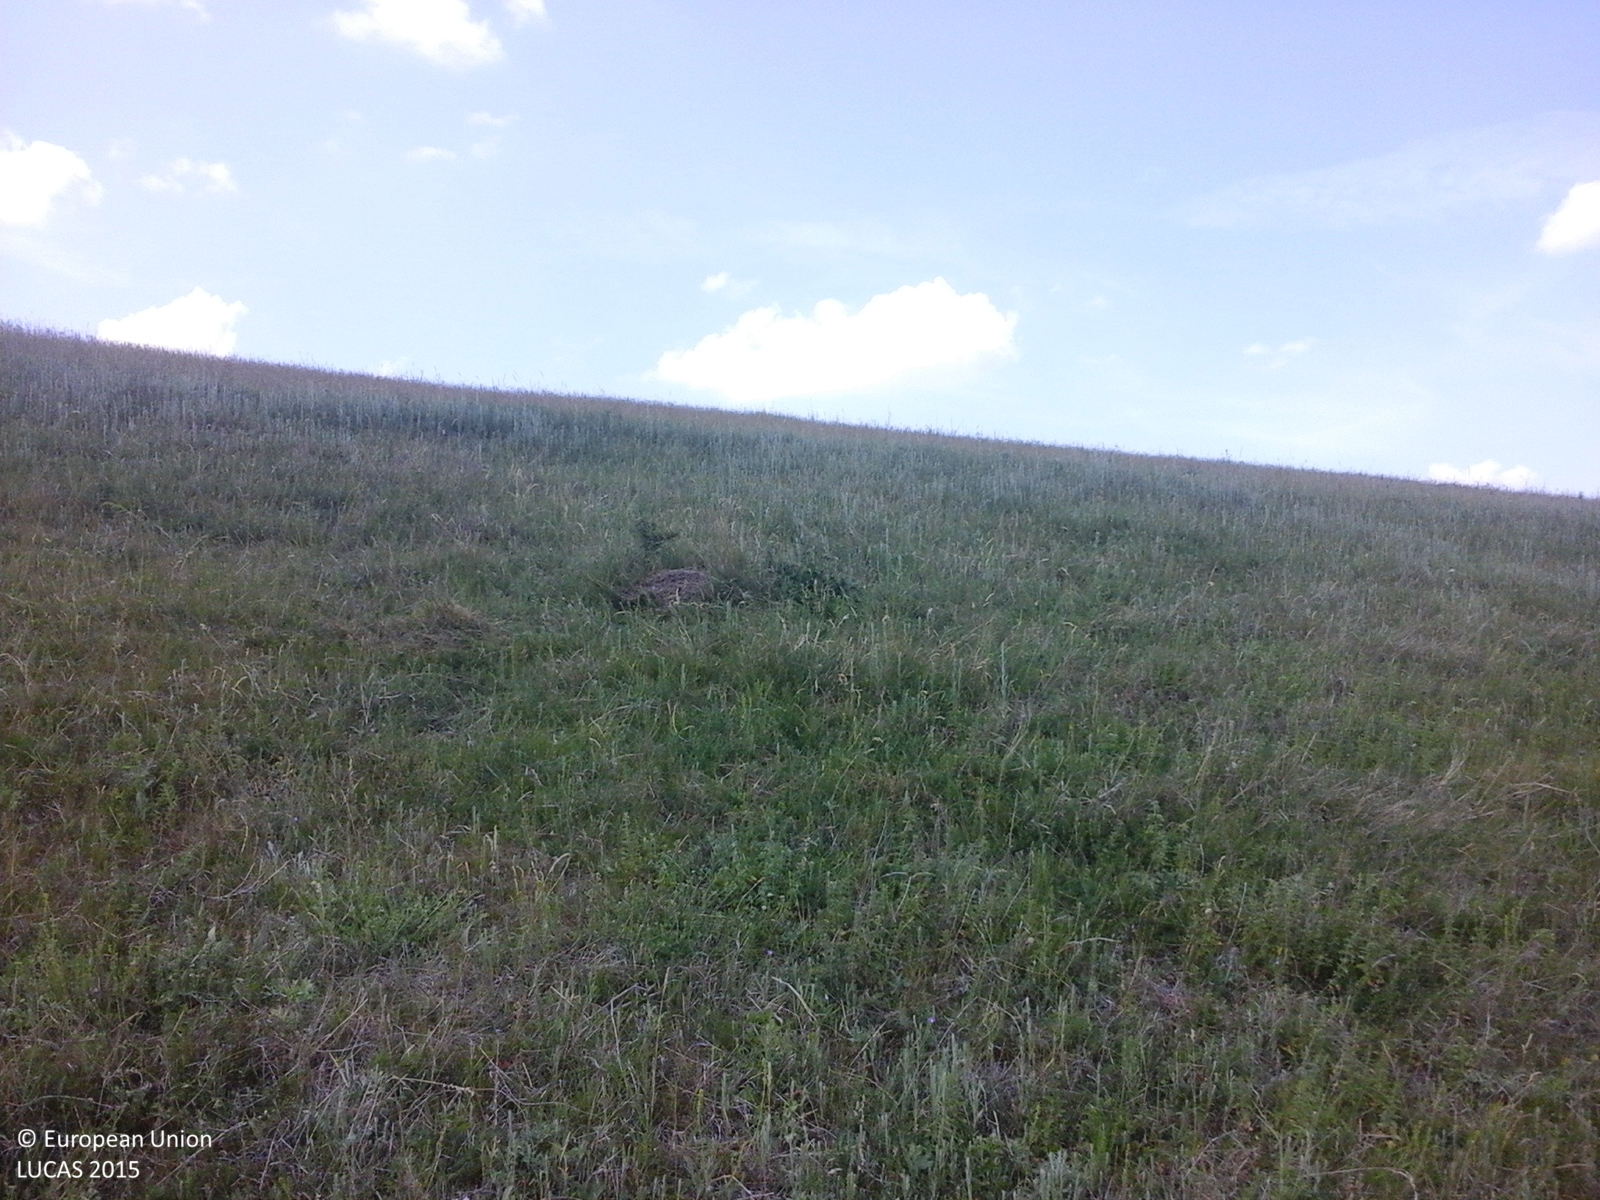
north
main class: Grassland
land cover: Grassland without tree/shrub cover
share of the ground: > 75 %
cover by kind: herbaceous plants 100 %
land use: Agriculture (excluding fallow land and kitchen gardens)
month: June
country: RO
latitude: 46.4273
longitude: 27.1331
